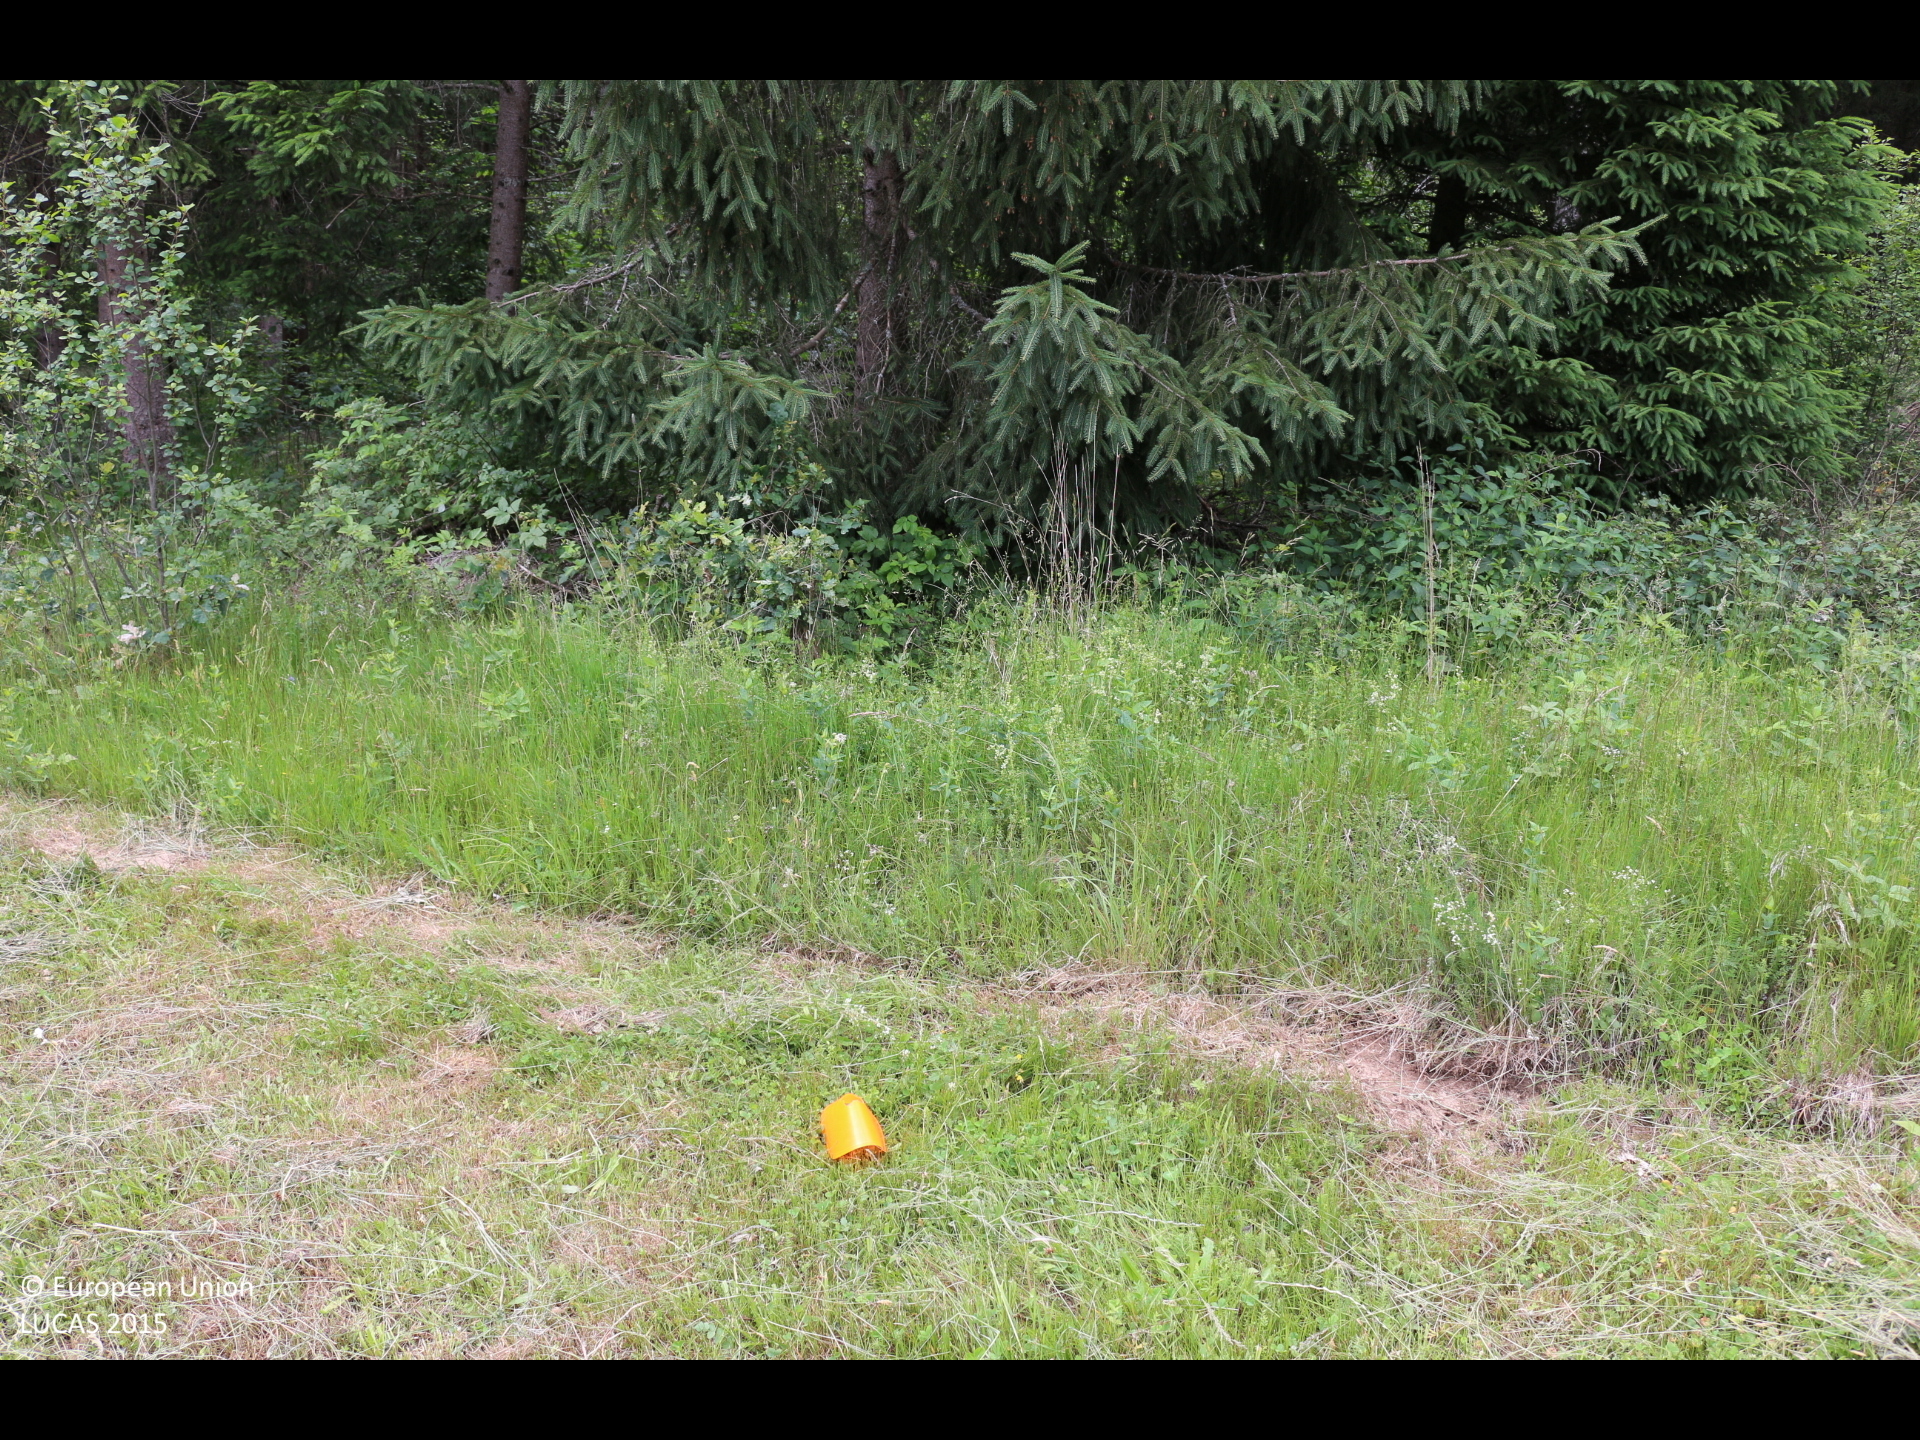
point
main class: Woodland
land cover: Spruce dominated coniferous woodland
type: alpine coniferous forest
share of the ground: > 75 %
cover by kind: coniferous forest trees 95 %, shrubs 5 %
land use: Forestry
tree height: > 5 m
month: June
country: AT
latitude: 46.8476
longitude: 14.1549
